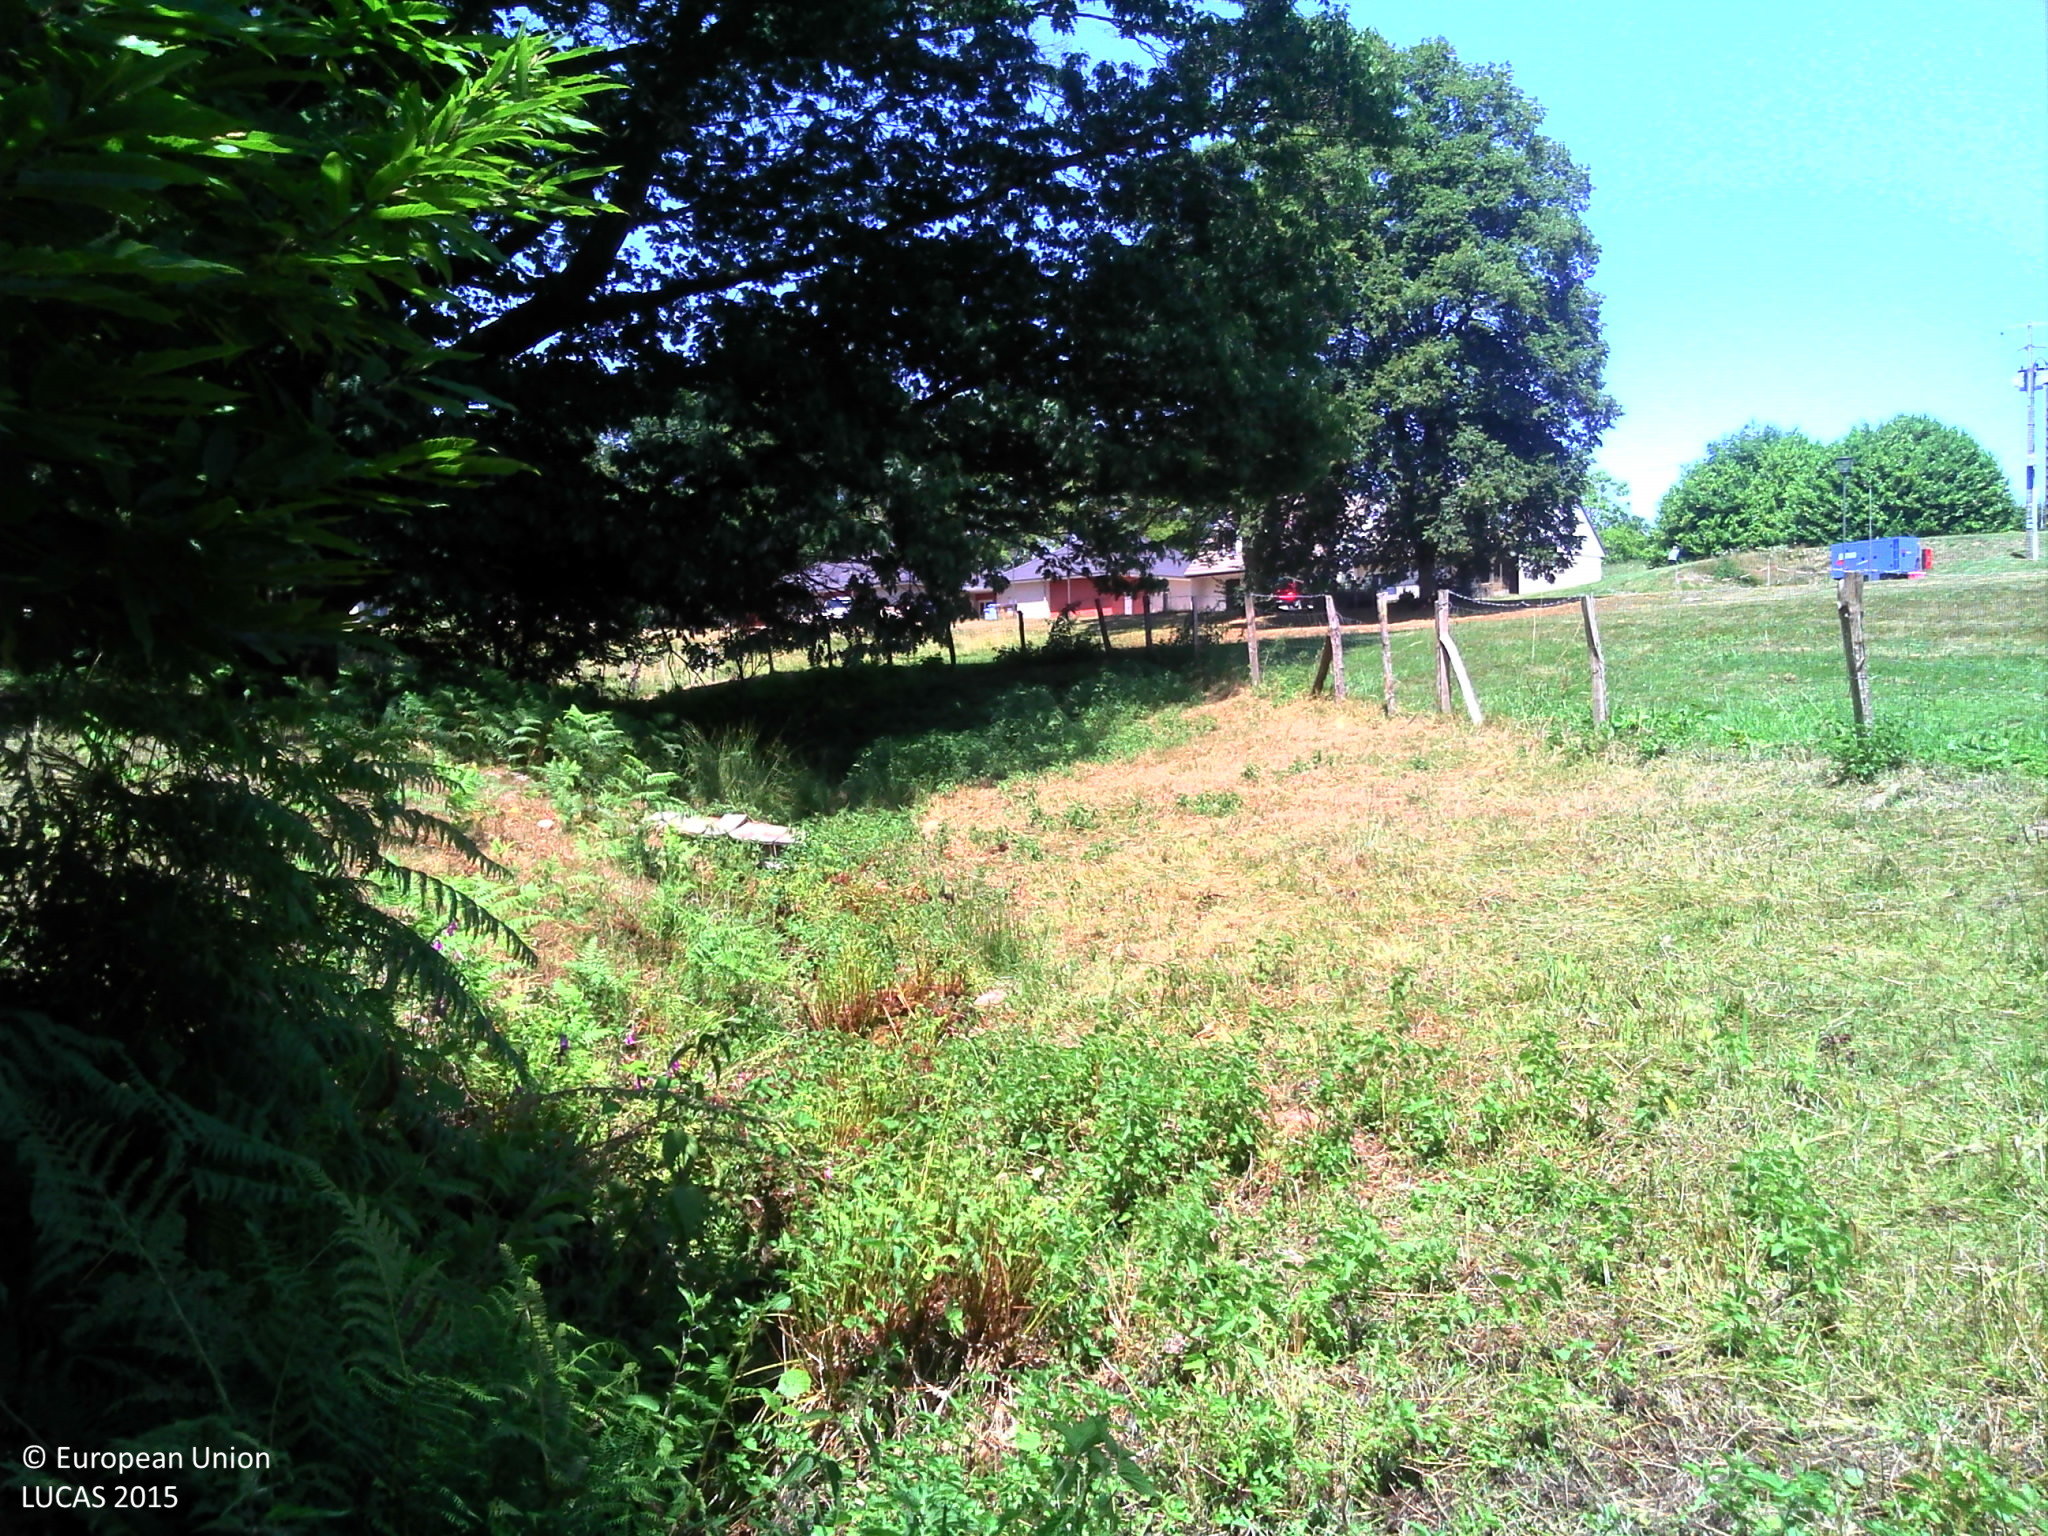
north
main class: Grassland
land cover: Grassland without tree/shrub cover
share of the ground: > 75 %
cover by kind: herbaceous plants 95 %, shrubs 5 %
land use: Community services
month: July
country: FR
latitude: 46.1344
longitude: 1.6692
